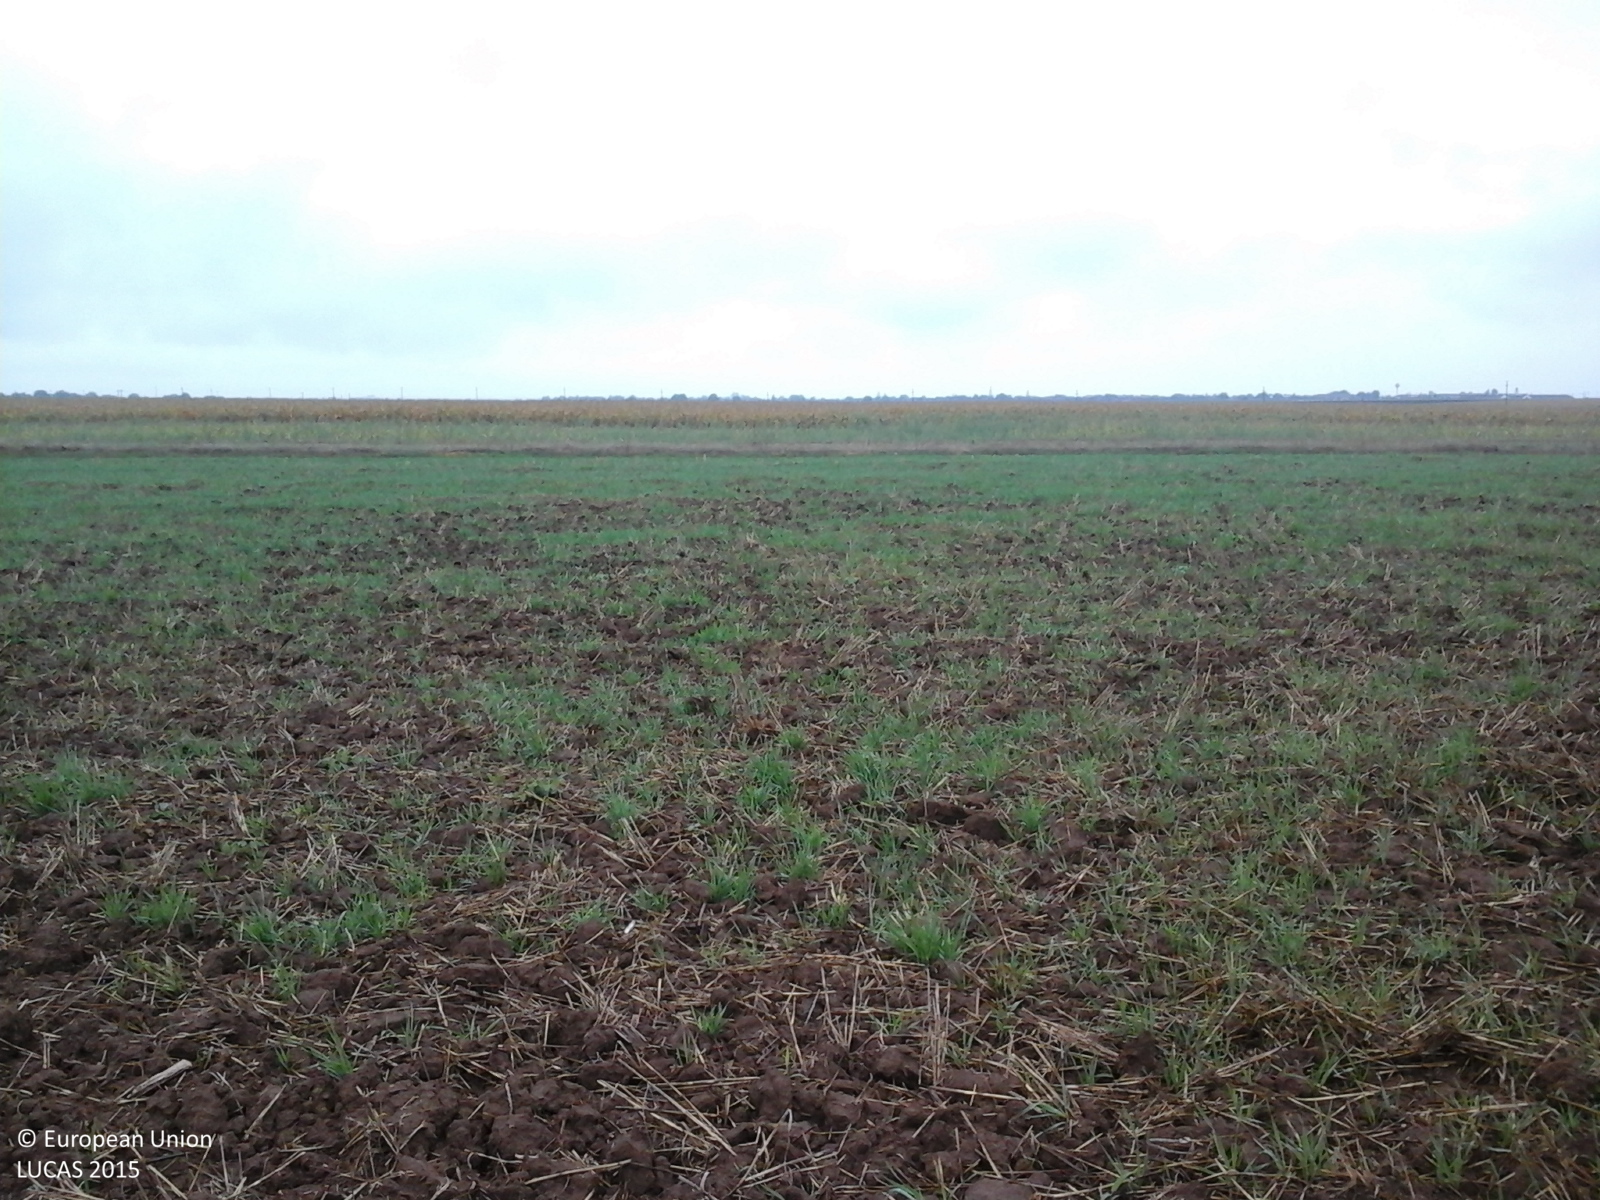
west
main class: Cropland
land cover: Common wheat
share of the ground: 25 - 50 %
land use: Agriculture (excluding fallow land and kitchen gardens)
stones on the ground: < 10 %
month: September
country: RO
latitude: 46.9561
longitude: 21.7515
